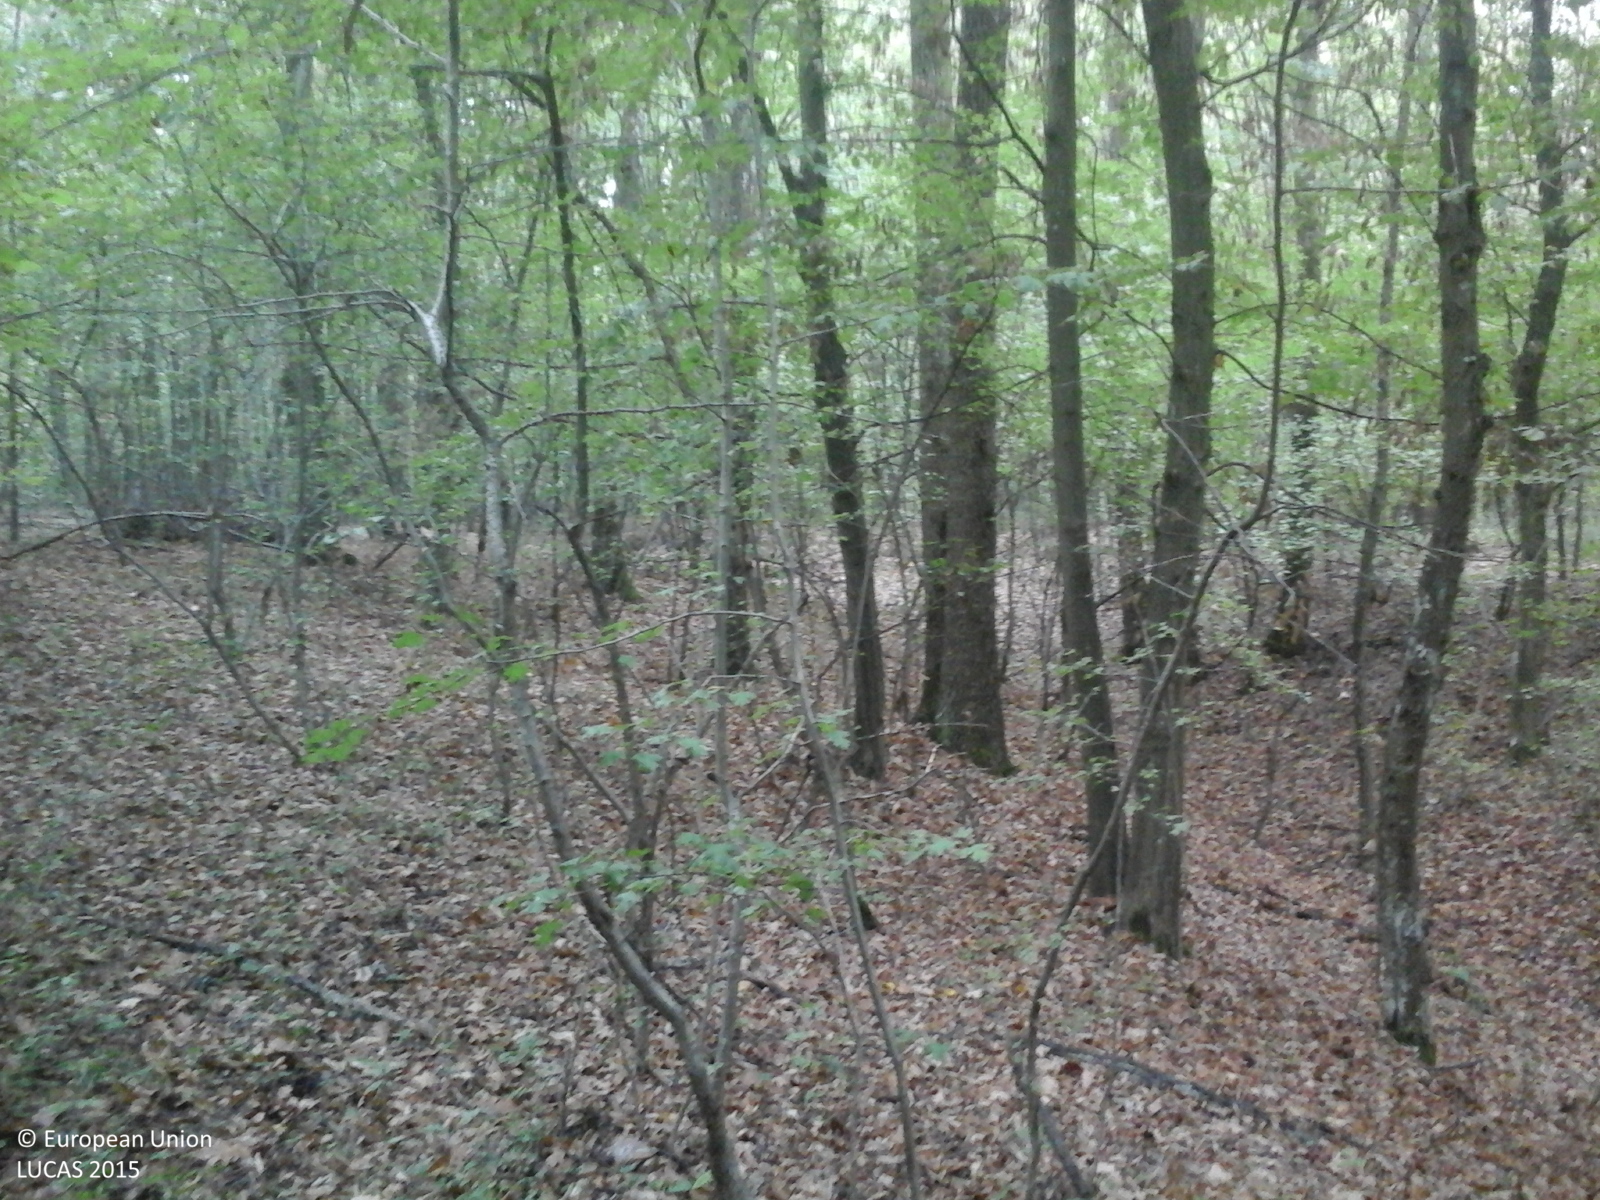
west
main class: Woodland
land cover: Broadleaved woodland
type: beech forest
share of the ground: > 75 %
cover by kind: broadleaved forest trees 100 %
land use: Forestry
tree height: > 5 m
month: September
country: RO
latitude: 44.9426
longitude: 23.2198
